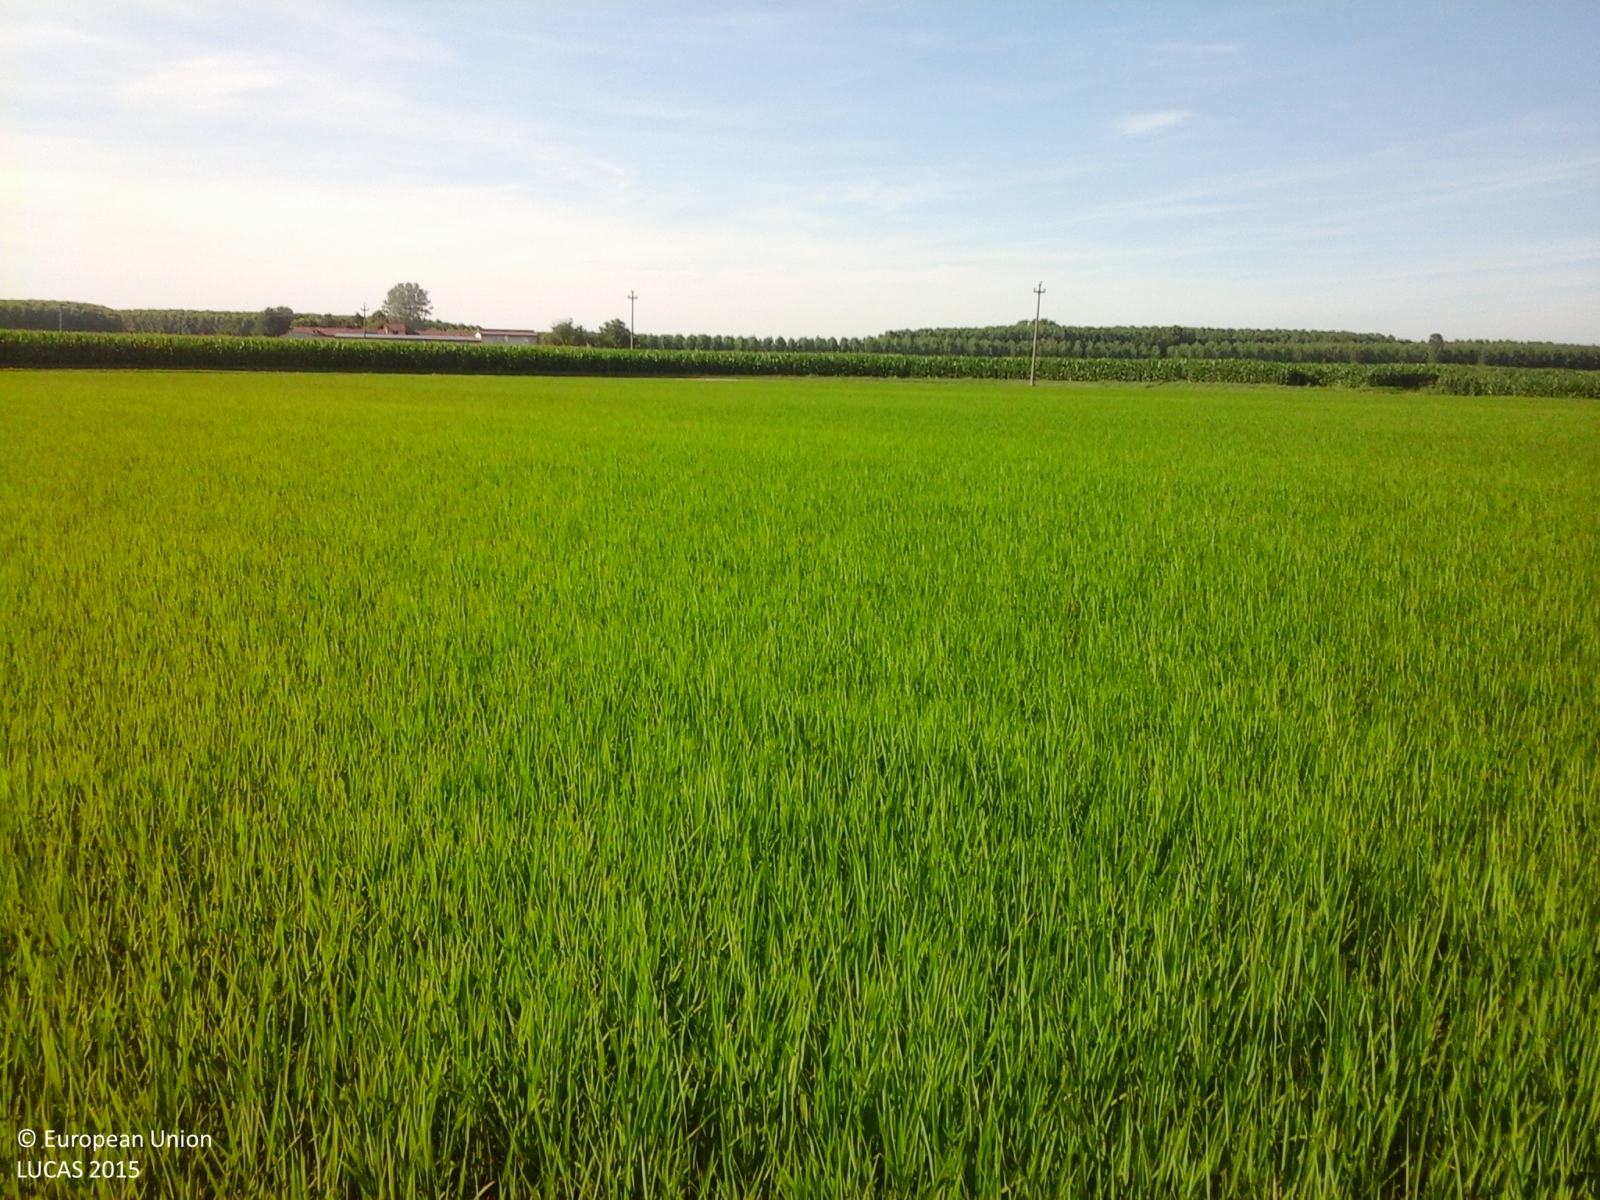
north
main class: Cropland
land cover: Maize
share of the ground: > 75 %
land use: Agriculture (excluding fallow land and kitchen gardens)
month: June
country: IT
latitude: 45.1161
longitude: 8.5662
